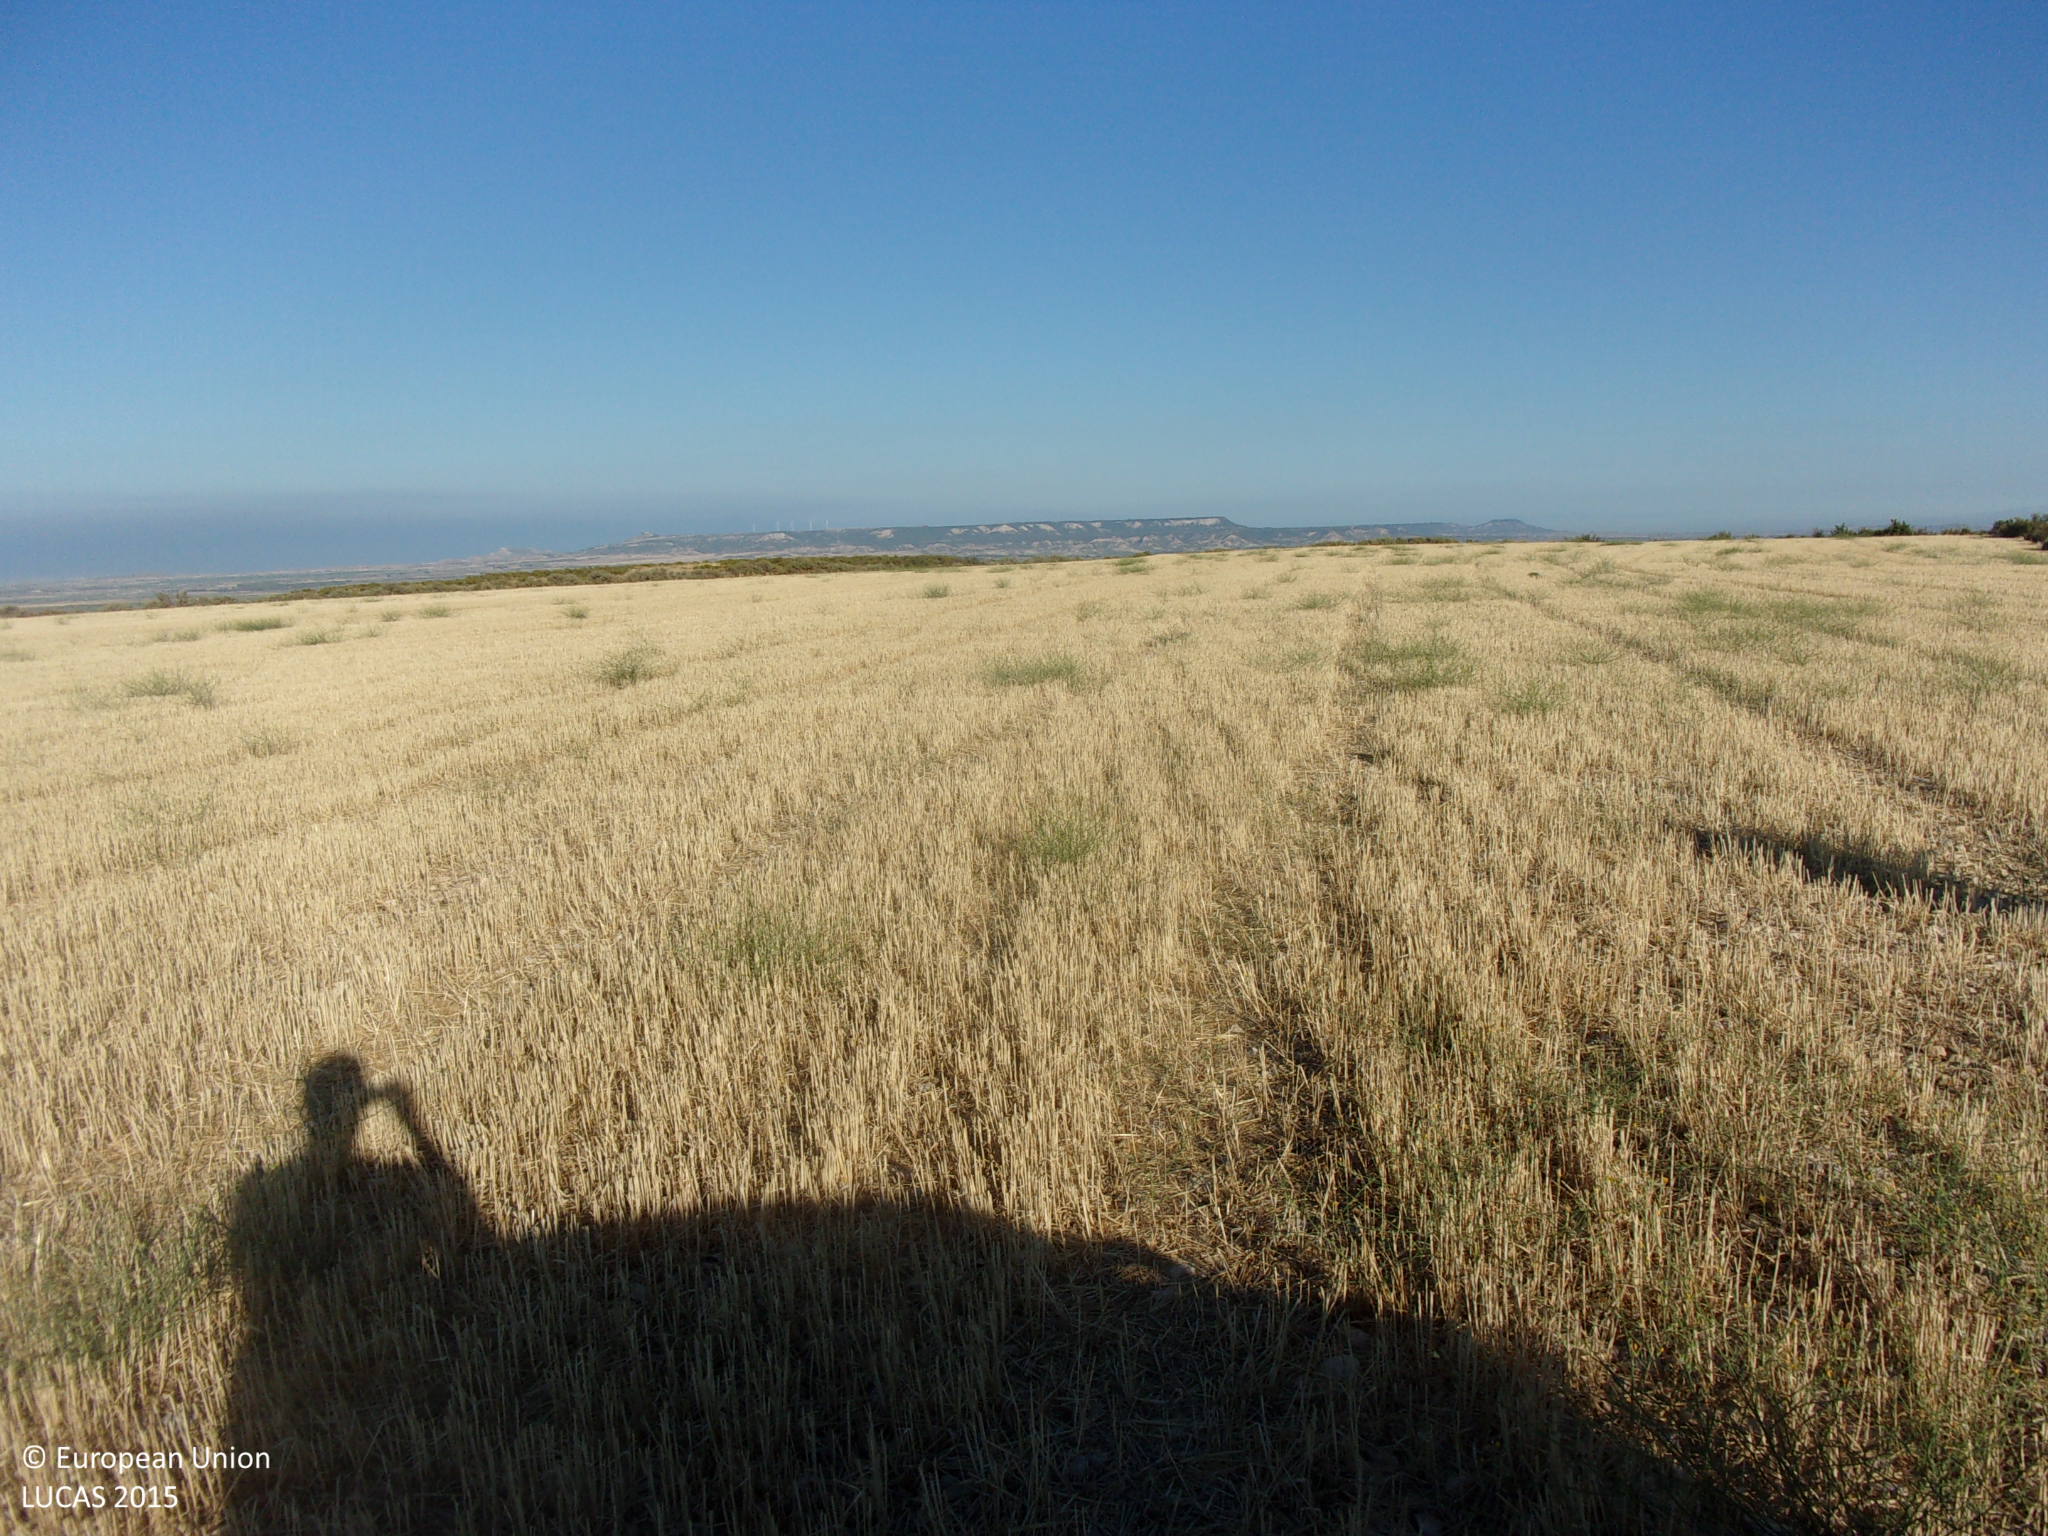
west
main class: Cropland
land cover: Barley
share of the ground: < 10 %
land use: Agriculture (excluding fallow land and kitchen gardens)
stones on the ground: > 50 %
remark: Harvested field
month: July
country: ES
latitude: 42.0236
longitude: -1.1018
